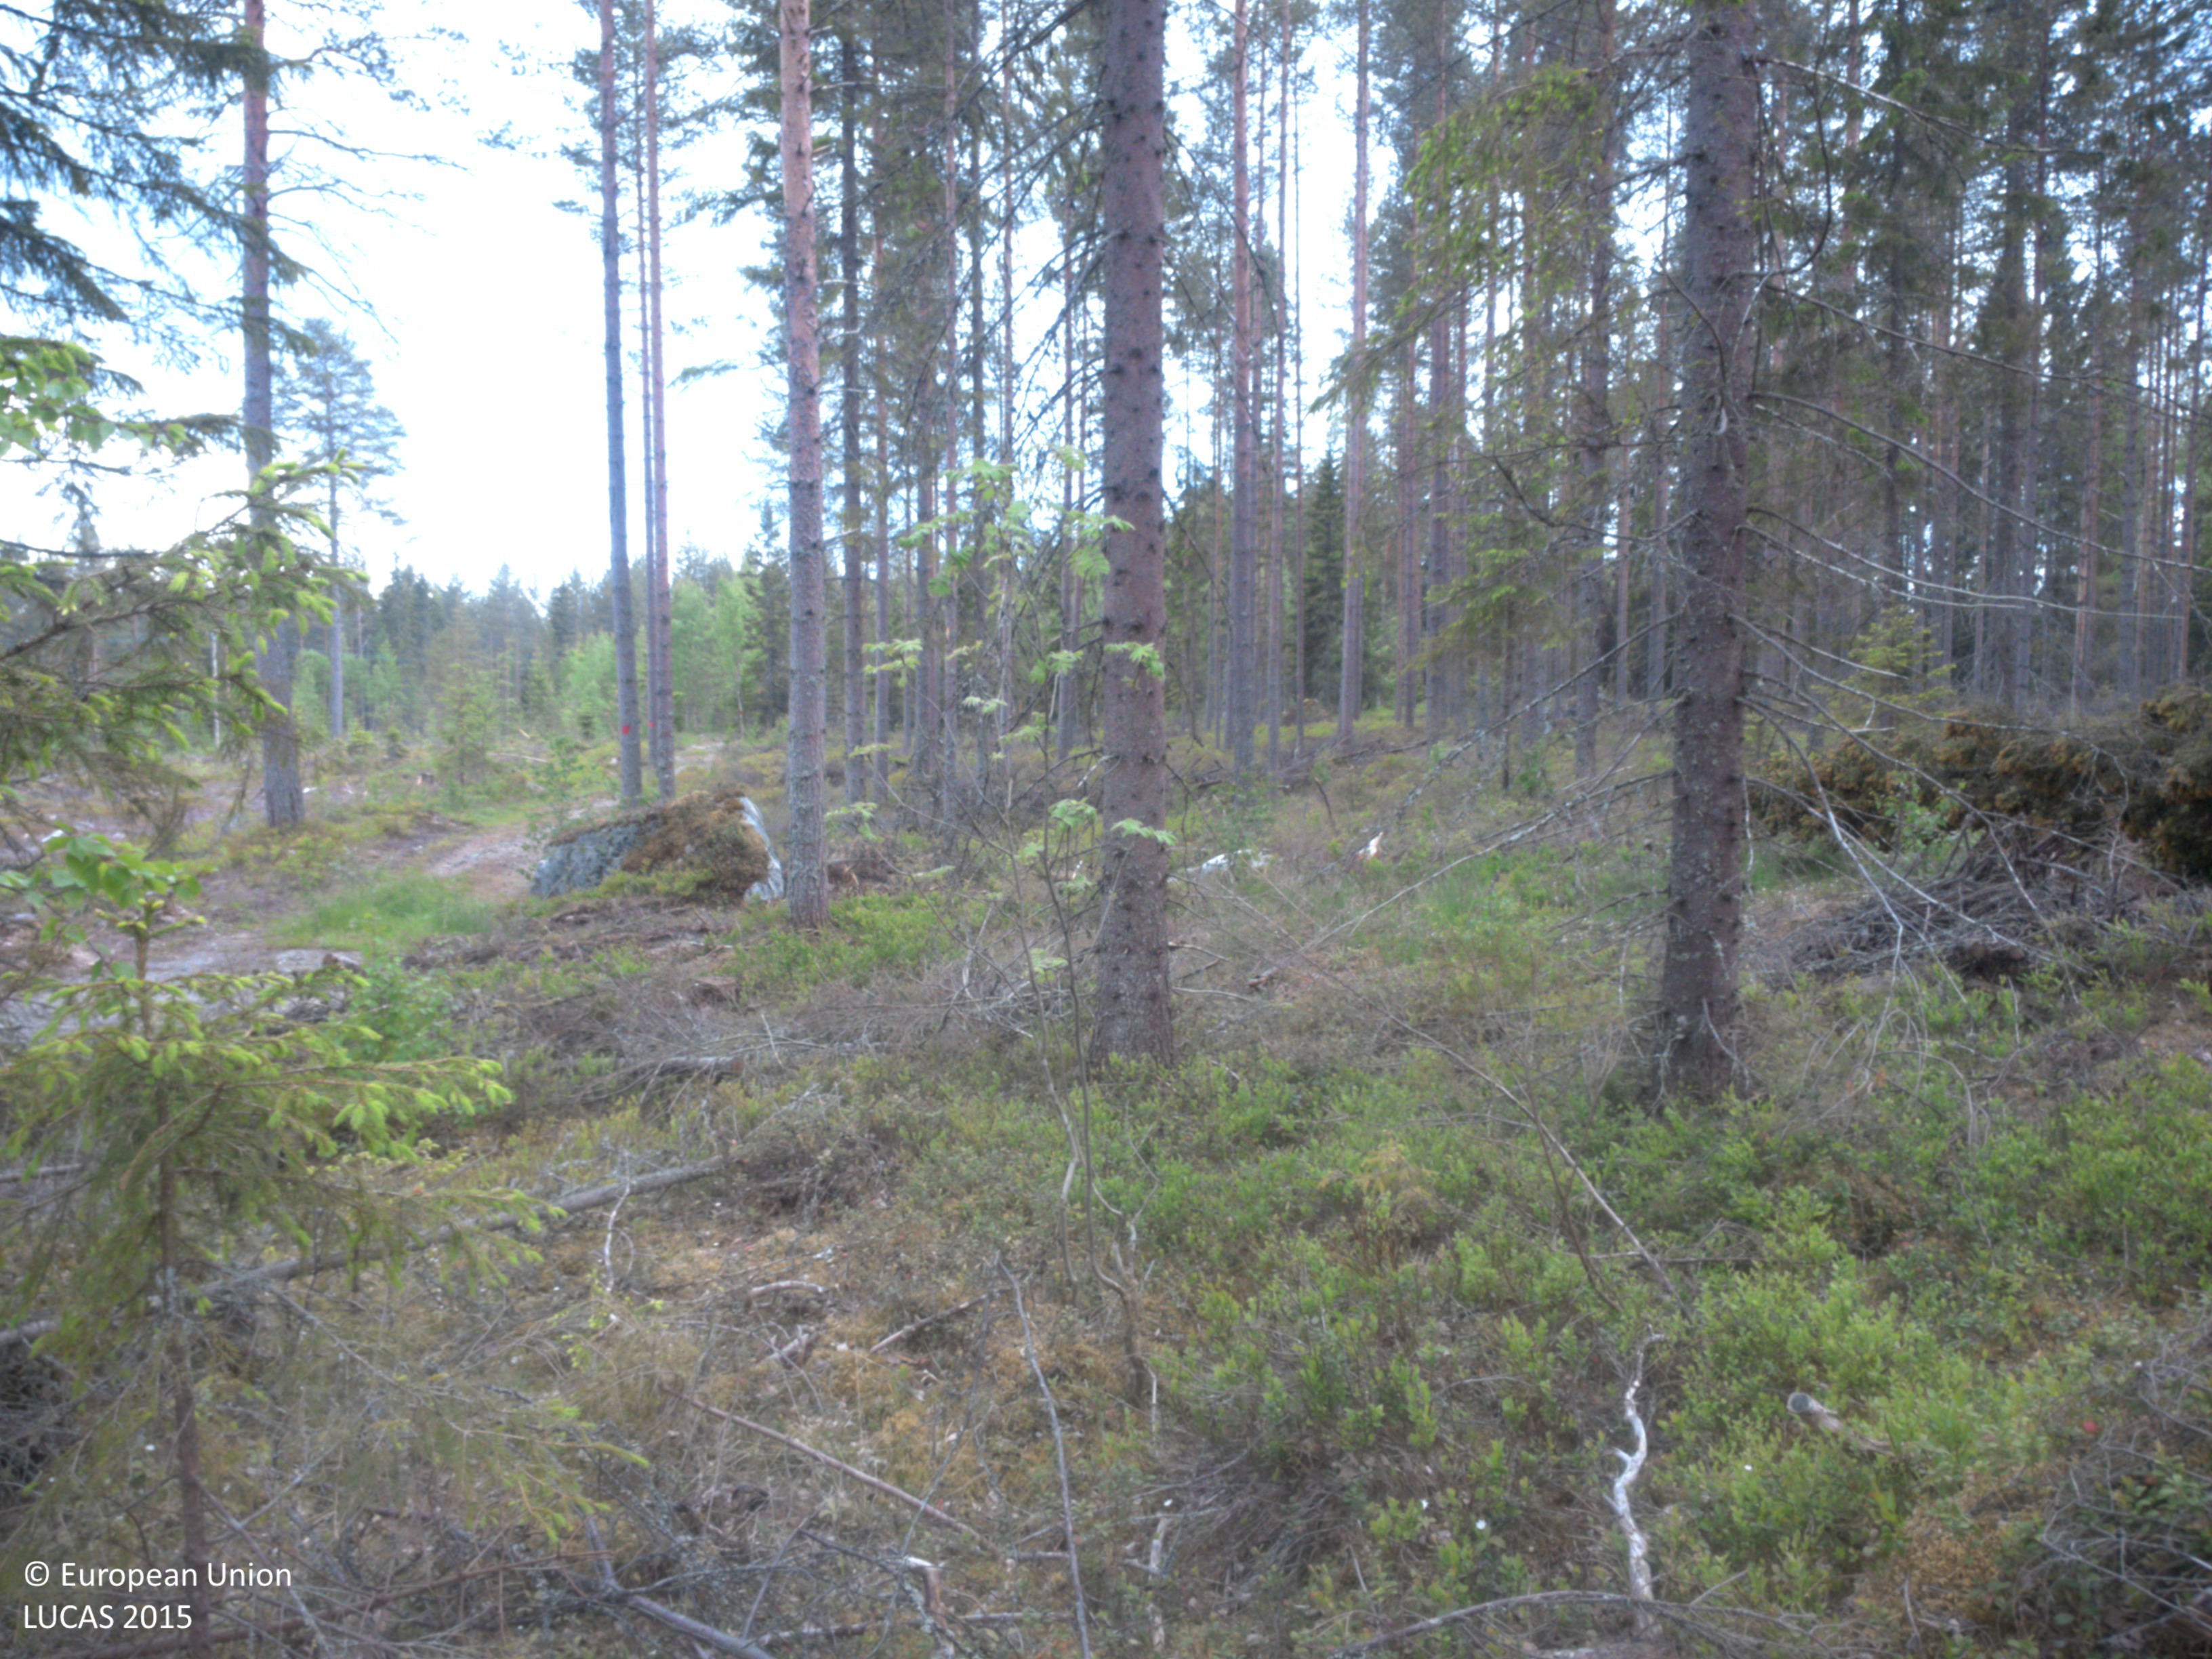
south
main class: Woodland
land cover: Pine dominated coniferous woodland
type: boreal forest
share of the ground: 25 - 50 %
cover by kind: herbaceous plants 30 %, coniferous forest trees 25 %, shrubs 20 %, lichens and mosses 15 %, unconsolidated bare surface 10 %
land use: Forestry
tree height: > 5 m
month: June
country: SE
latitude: 63.5824
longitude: 19.8326
